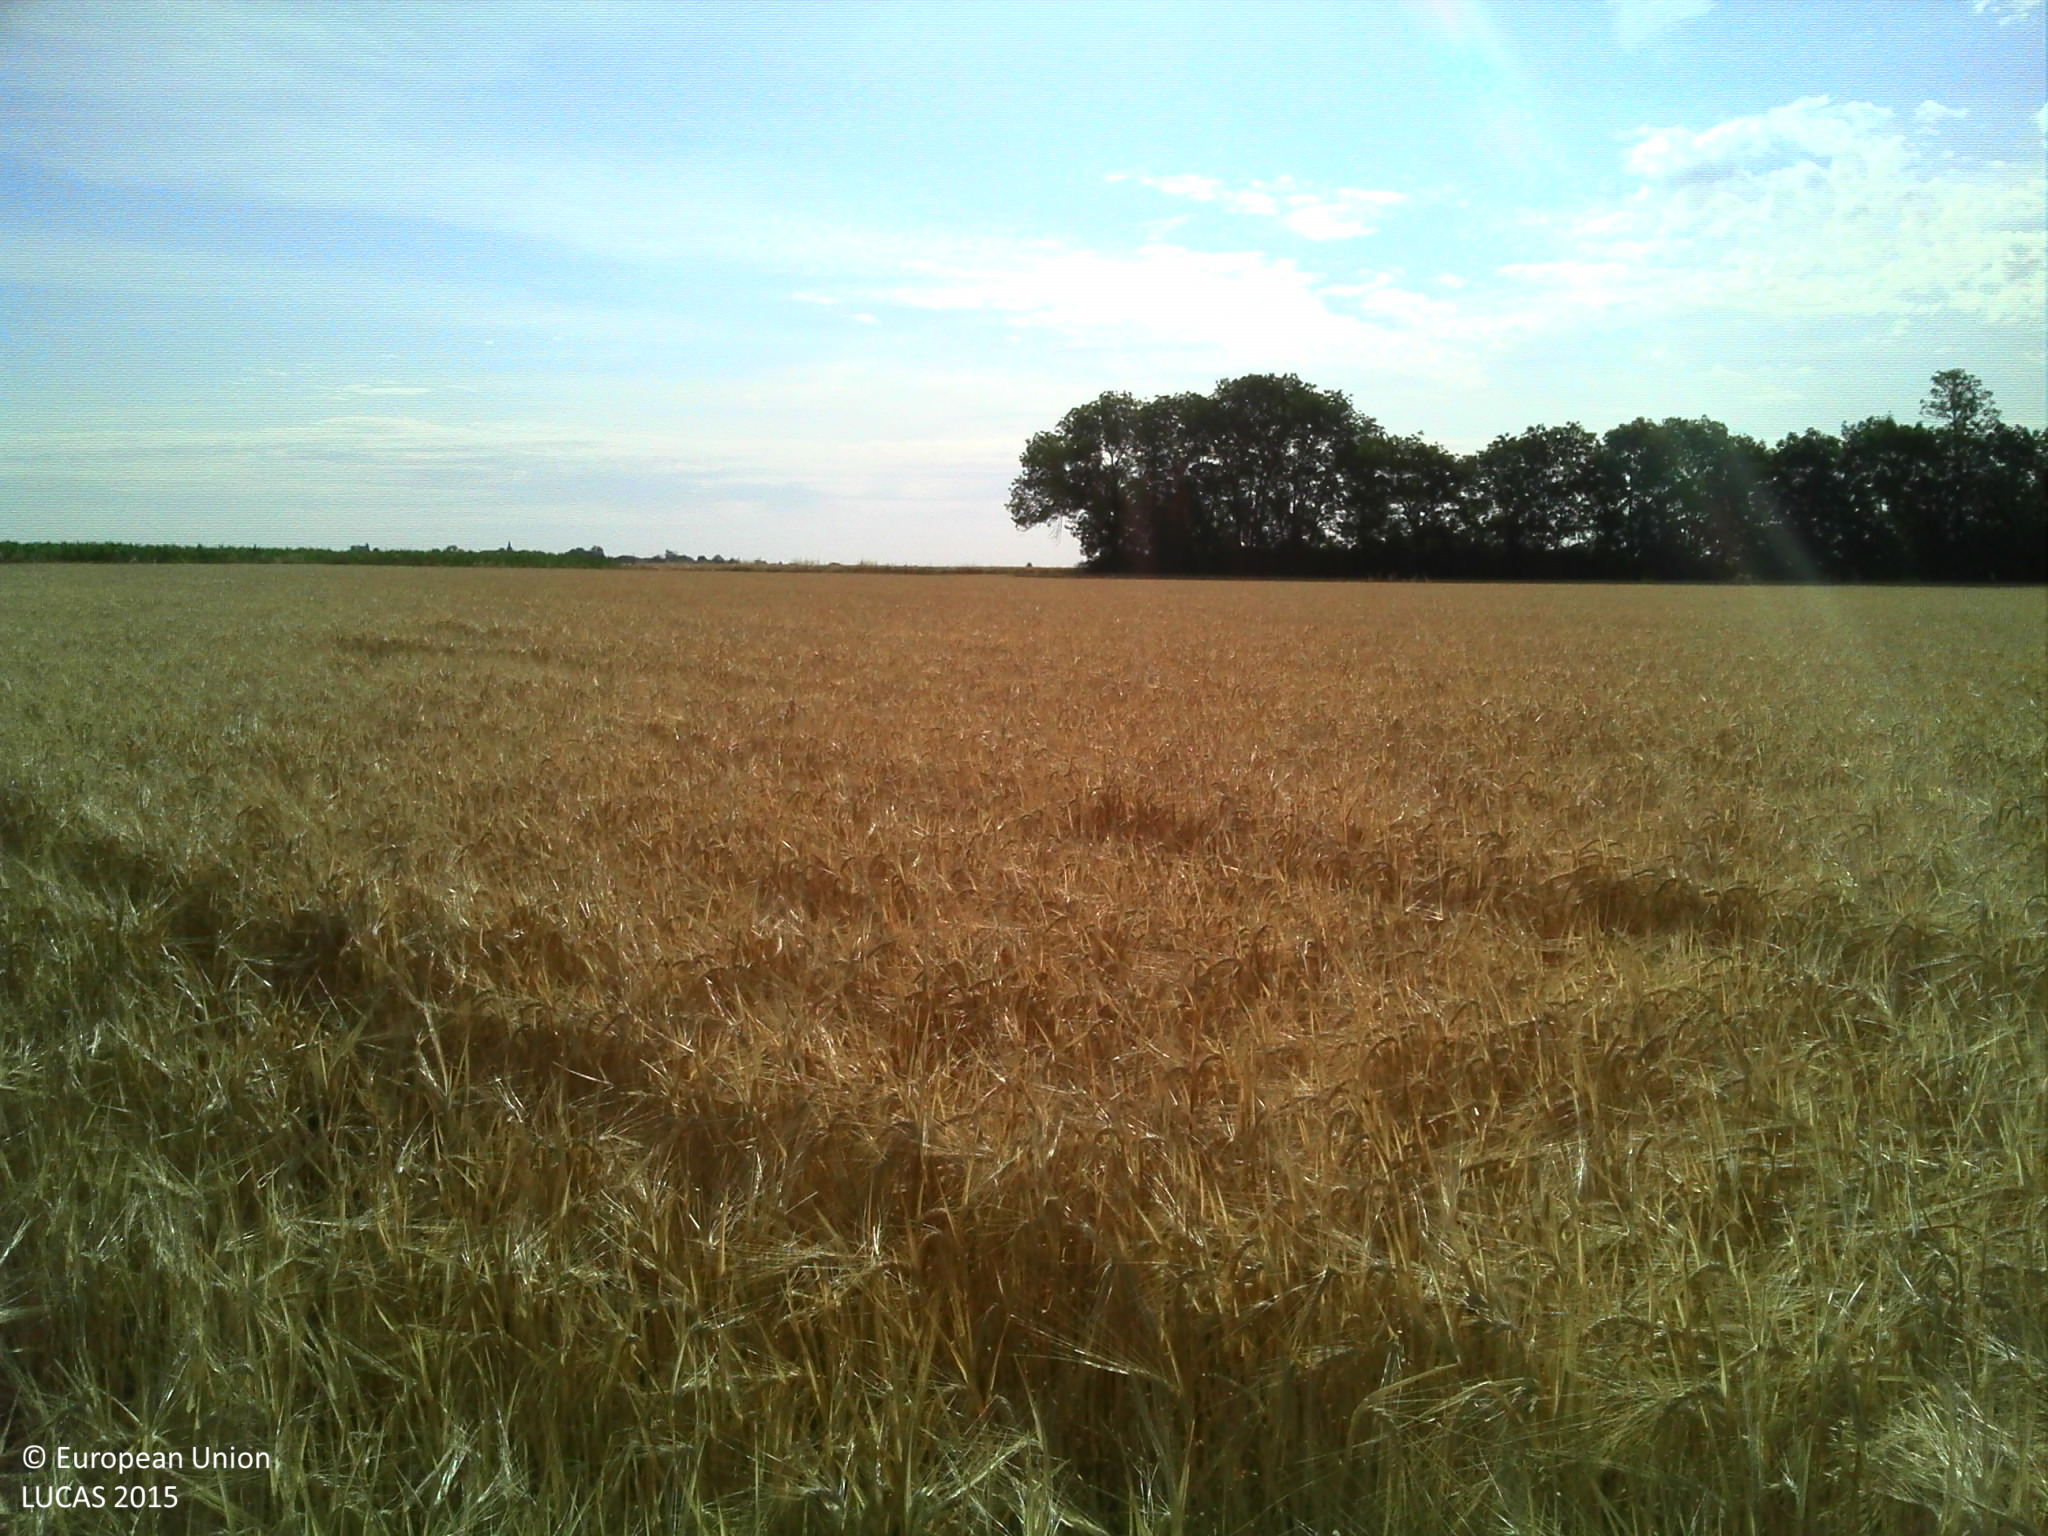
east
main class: Cropland
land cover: Barley
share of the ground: > 75 %
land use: Agriculture (excluding fallow land and kitchen gardens)
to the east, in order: Barley; Grass margins; Abandoned hedges; Paved roads, cycling and walking lanes; Grass margins; Ditches and canals; Other bare soil; Barley; Common wheat
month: July
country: FR
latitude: 48.4946
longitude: 6.0351
